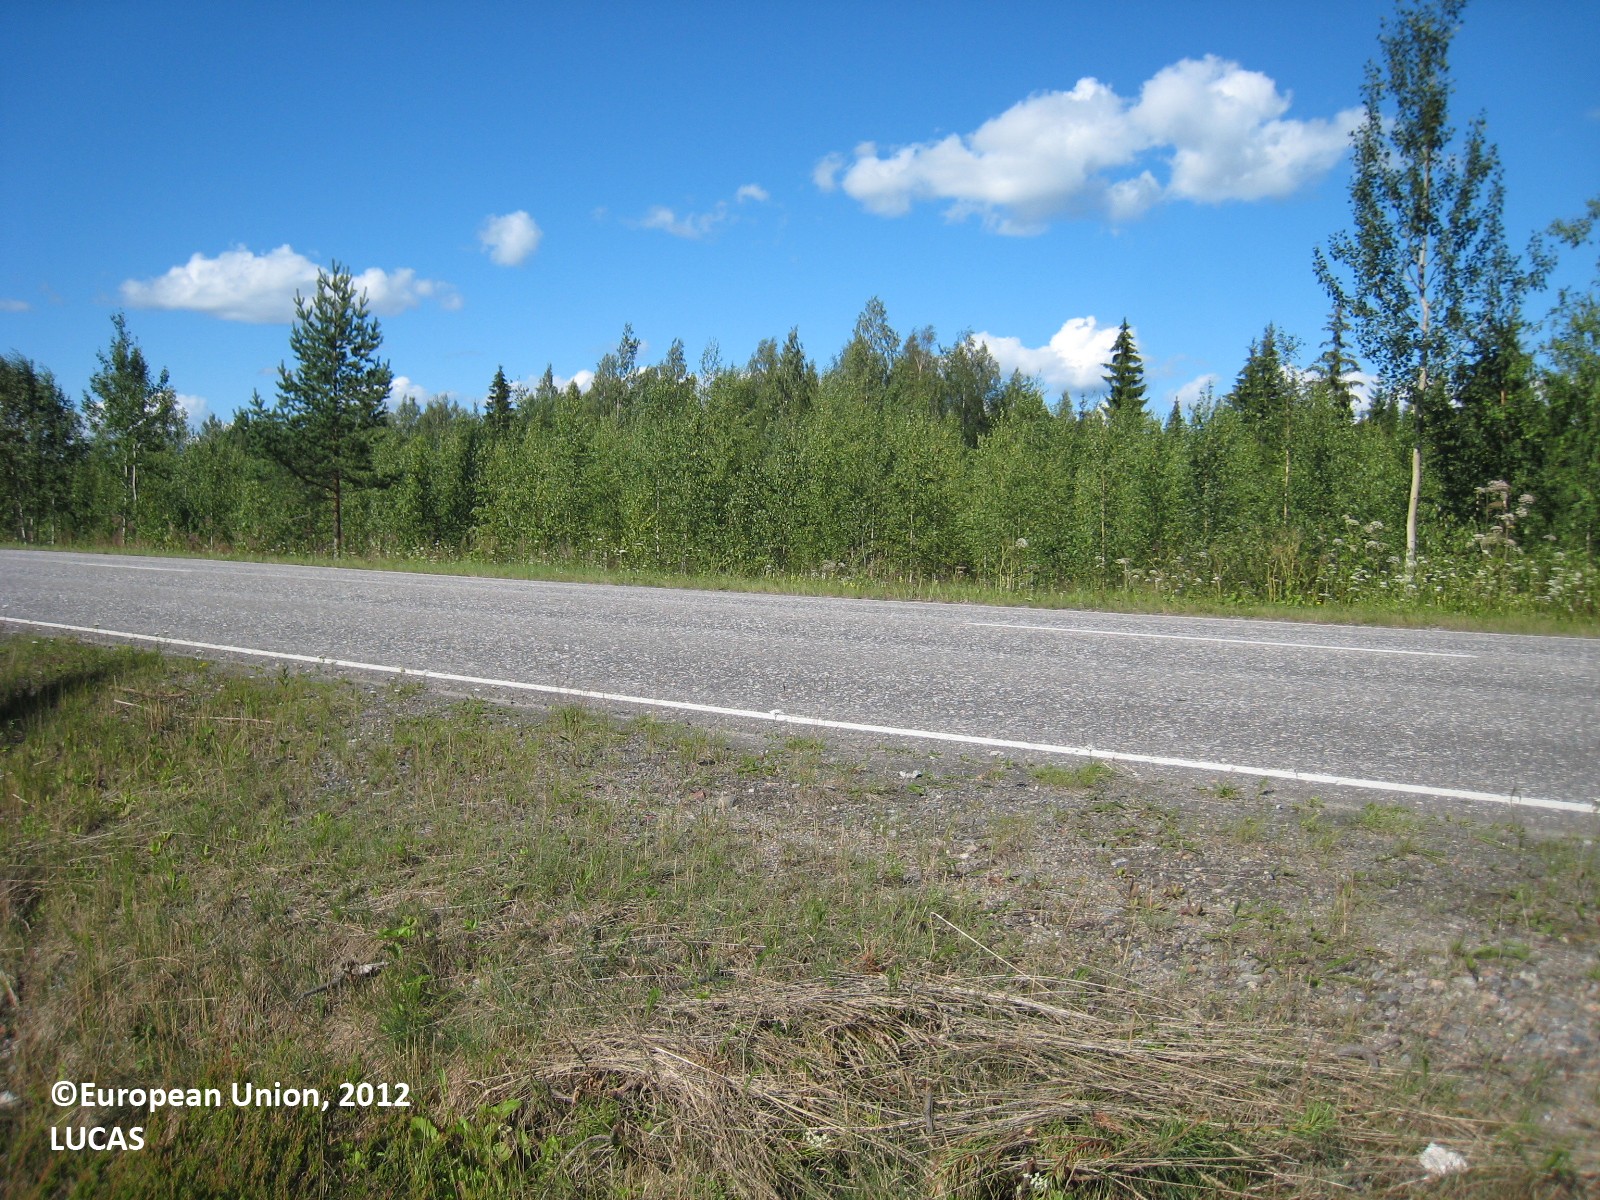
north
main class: Grassland
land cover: Grassland with sparse tree/shrub cover
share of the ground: > 75 %
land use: Road transport
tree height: < 5 m
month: July
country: FI
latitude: 62.9545
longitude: 26.7986
